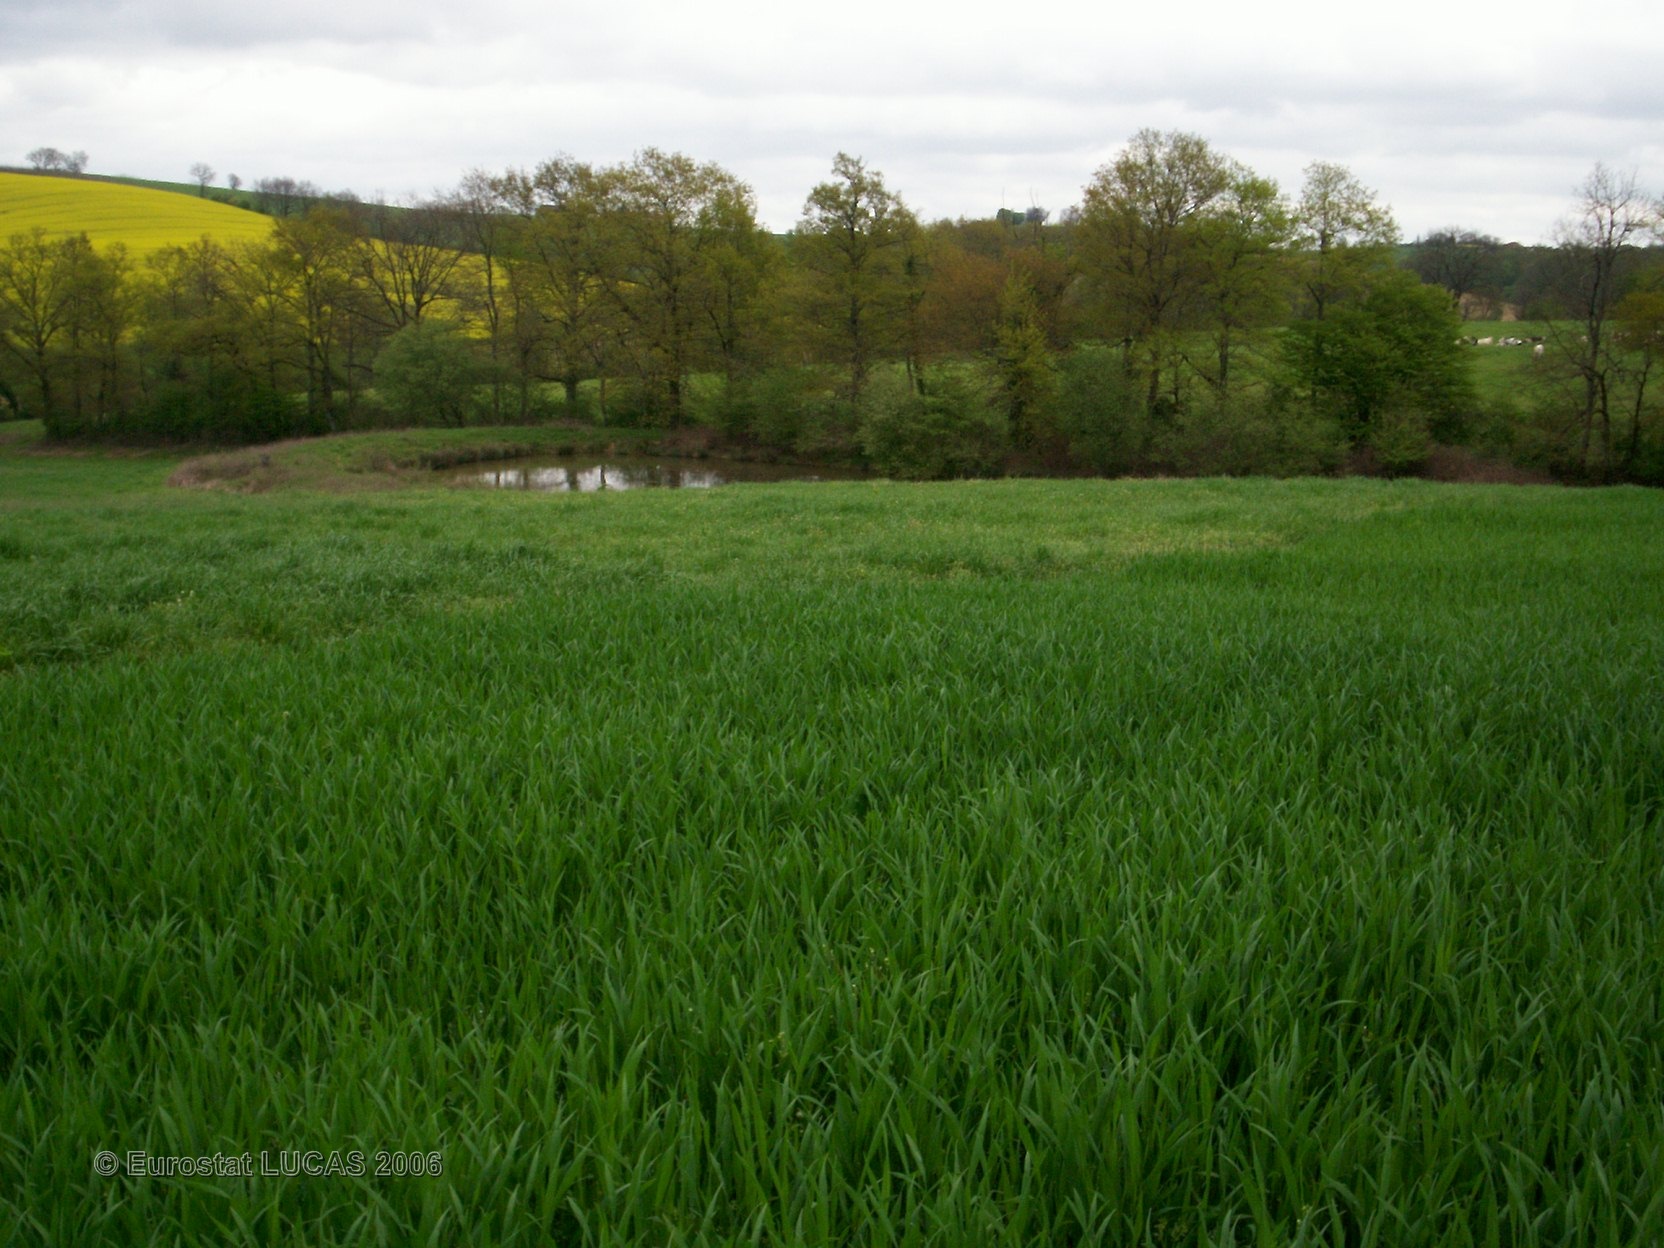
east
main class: Cropland
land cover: Barley
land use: Agriculture (excluding fallow land and kitchen gardens)
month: April
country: FR
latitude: 43.7021
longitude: 0.1792
